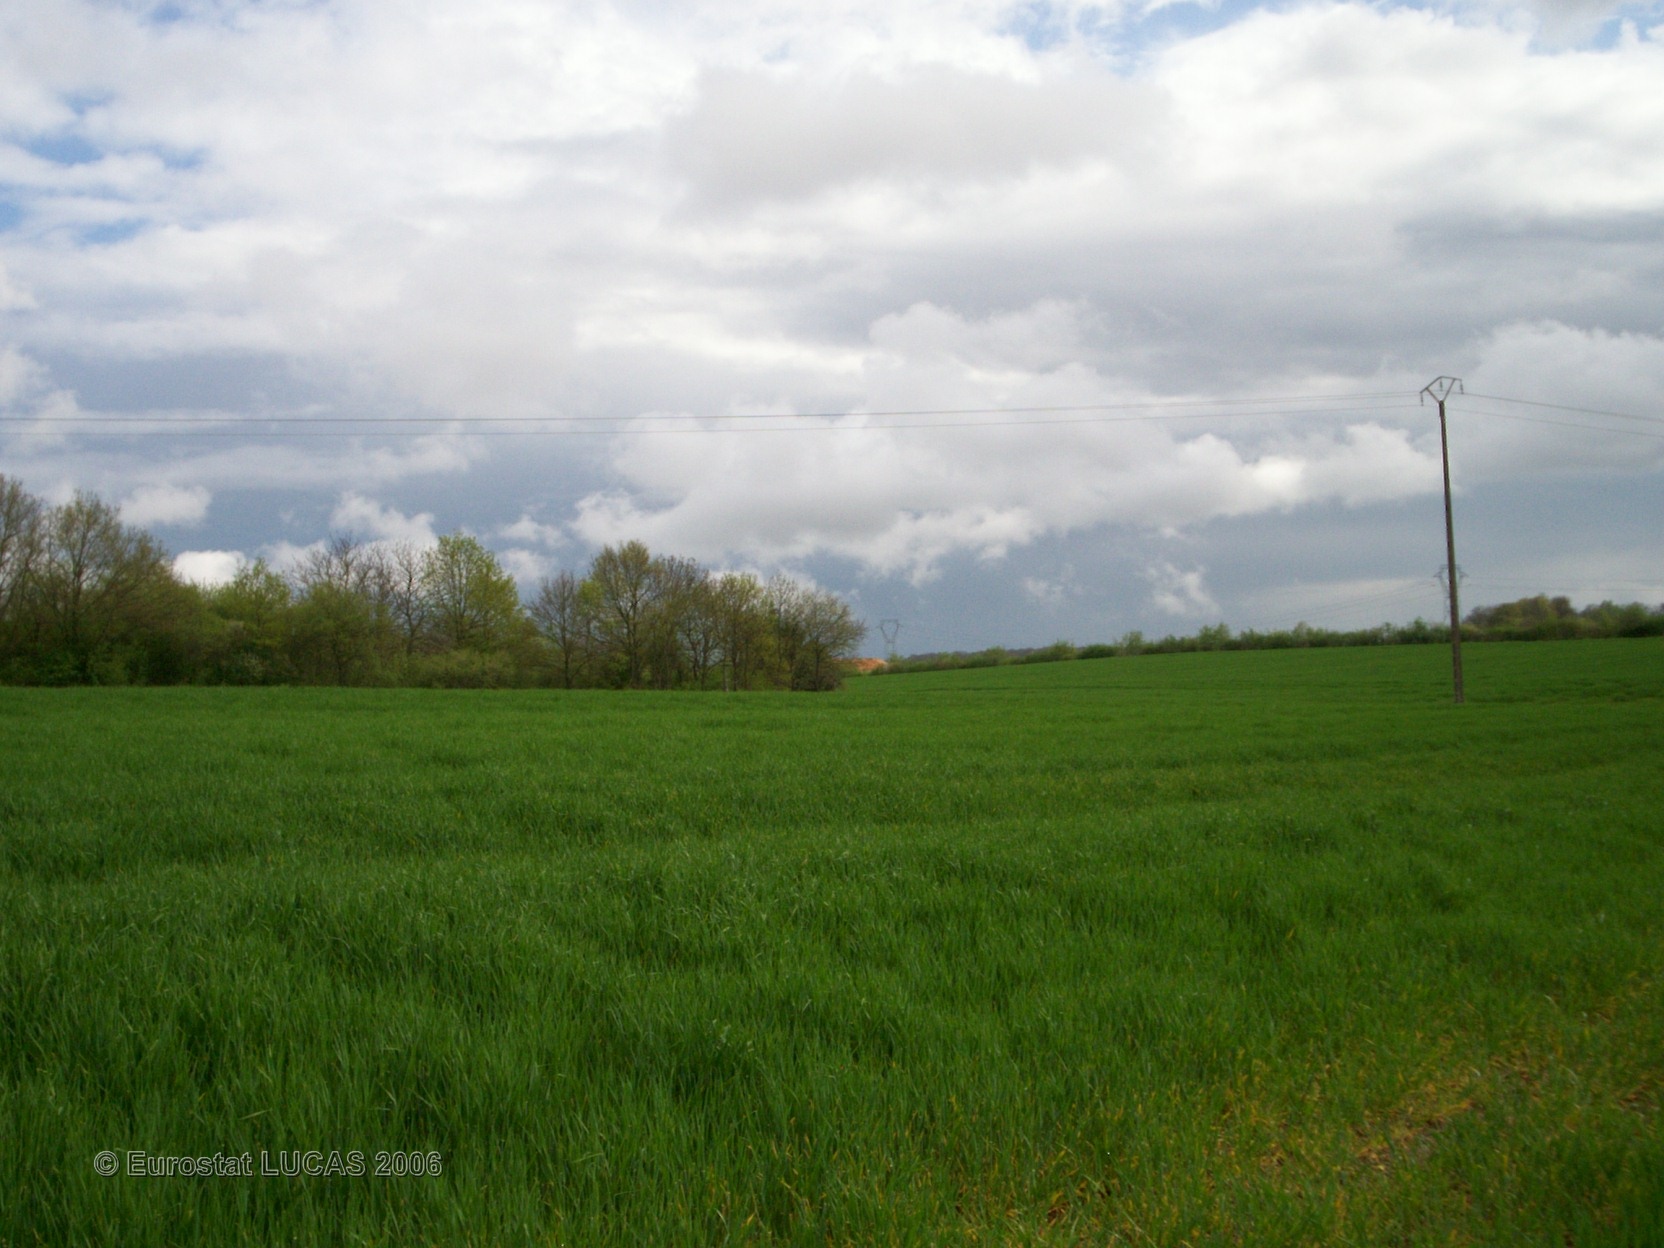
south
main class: Cropland
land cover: Barley
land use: Agriculture (excluding fallow land and kitchen gardens)
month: April
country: FR
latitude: 48.2863
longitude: 2.9435
